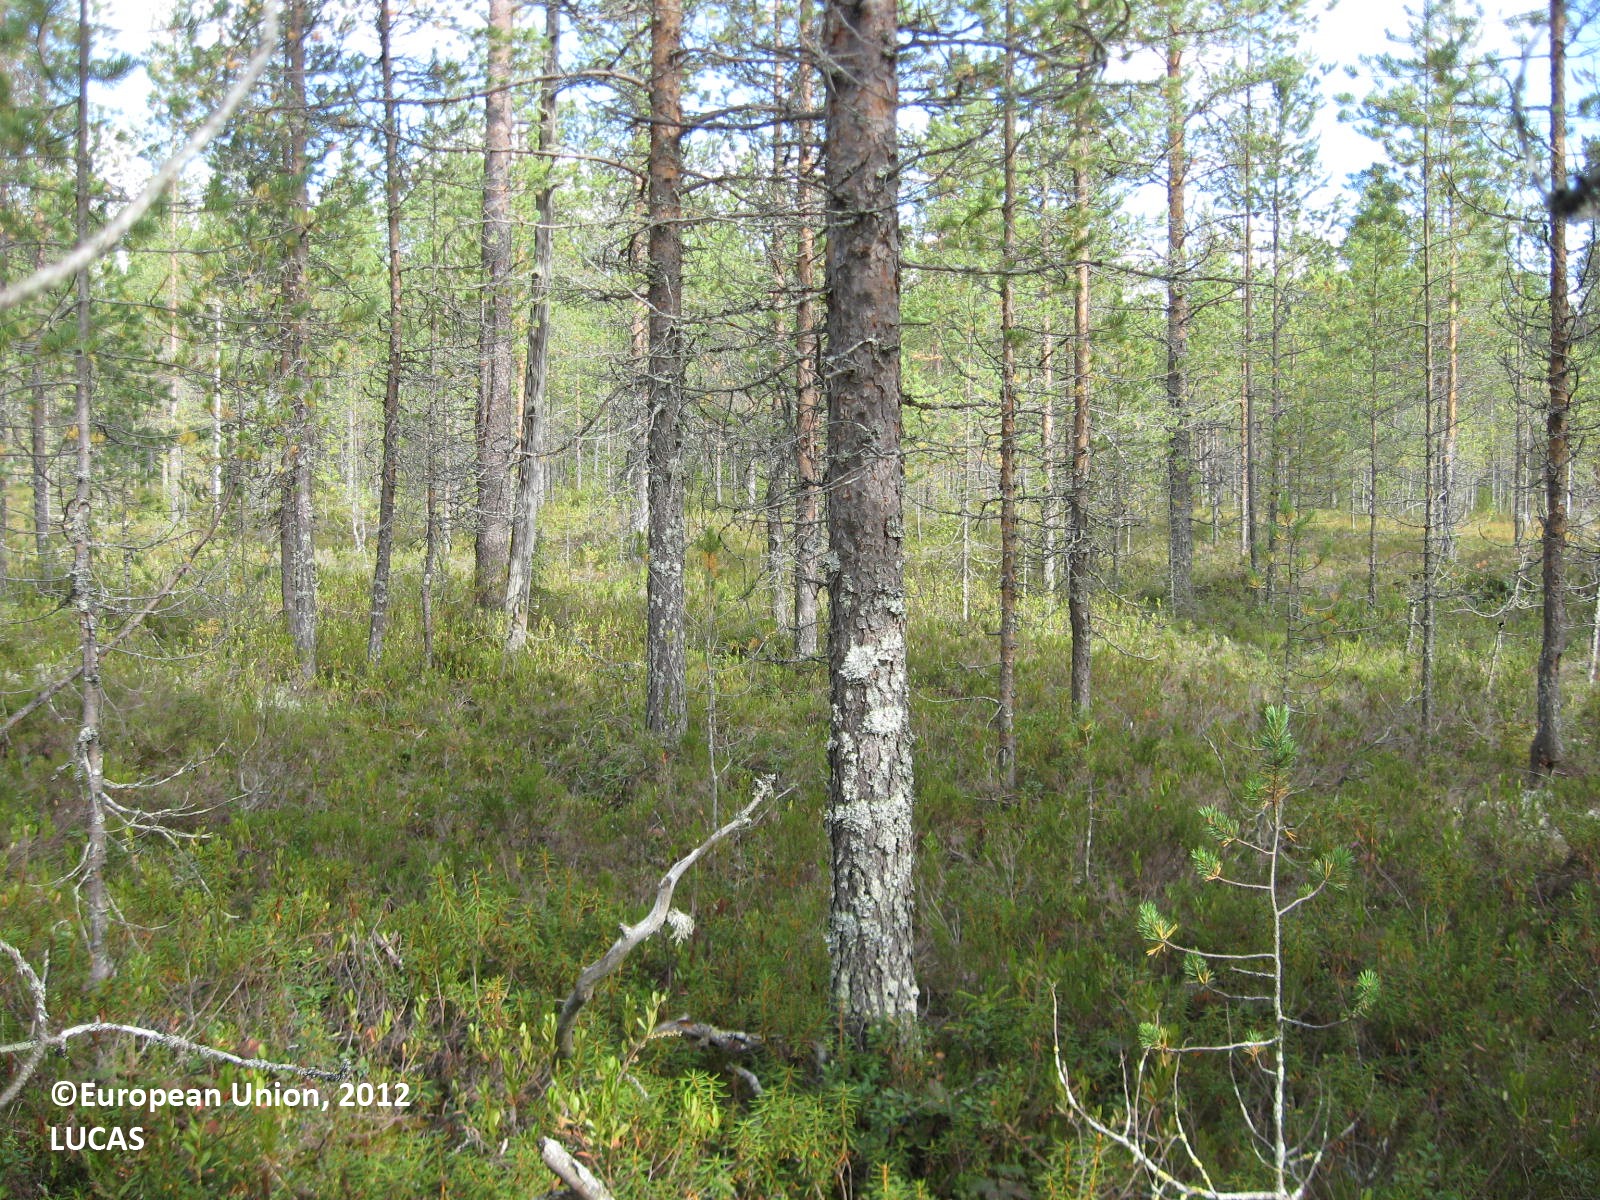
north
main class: Woodland
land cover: Pine dominated coniferous woodland
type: boreal forest
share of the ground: 50 - 75 %
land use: Forestry
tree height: > 5 m
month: August
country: FI
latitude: 63.6654
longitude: 29.5634
